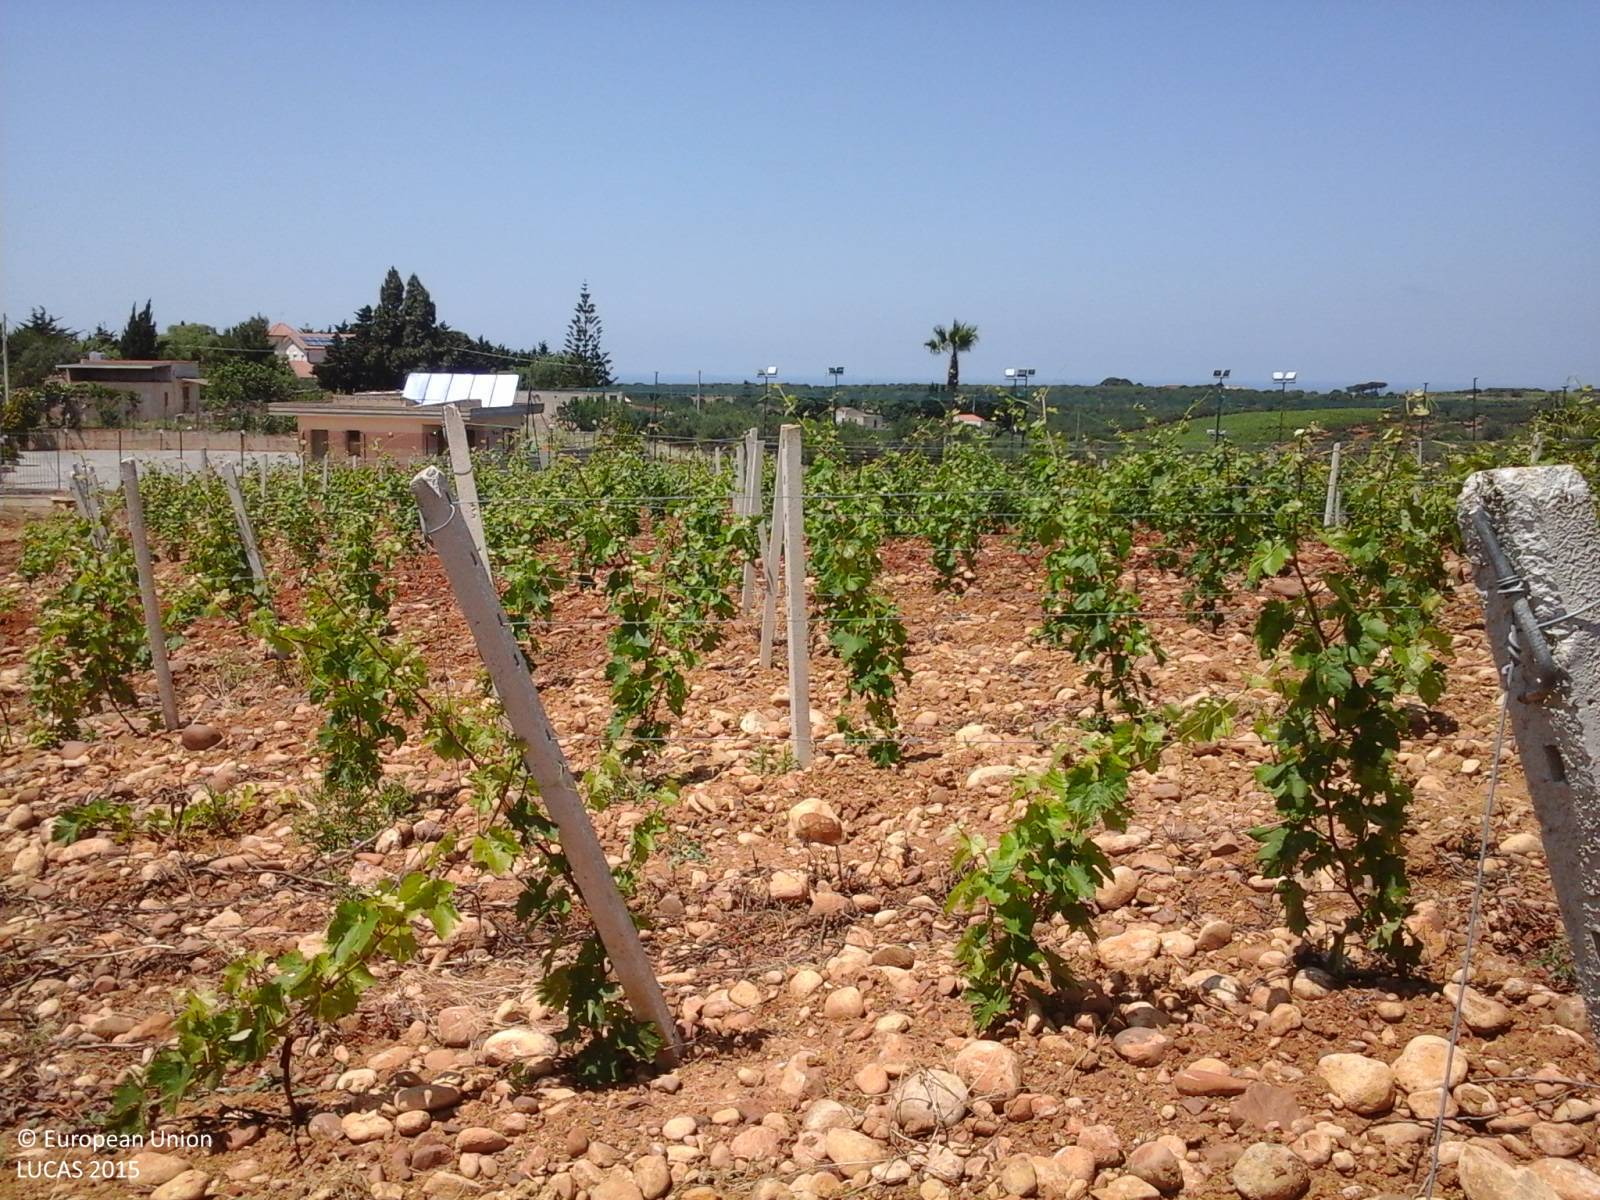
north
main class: Cropland
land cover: Vineyards
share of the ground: 25 - 50 %
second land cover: Other bare soil
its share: > 75 %
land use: Agriculture (excluding fallow land and kitchen gardens)
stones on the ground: > 50 %
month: June
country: IT
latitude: 37.9910
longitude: 12.9959
